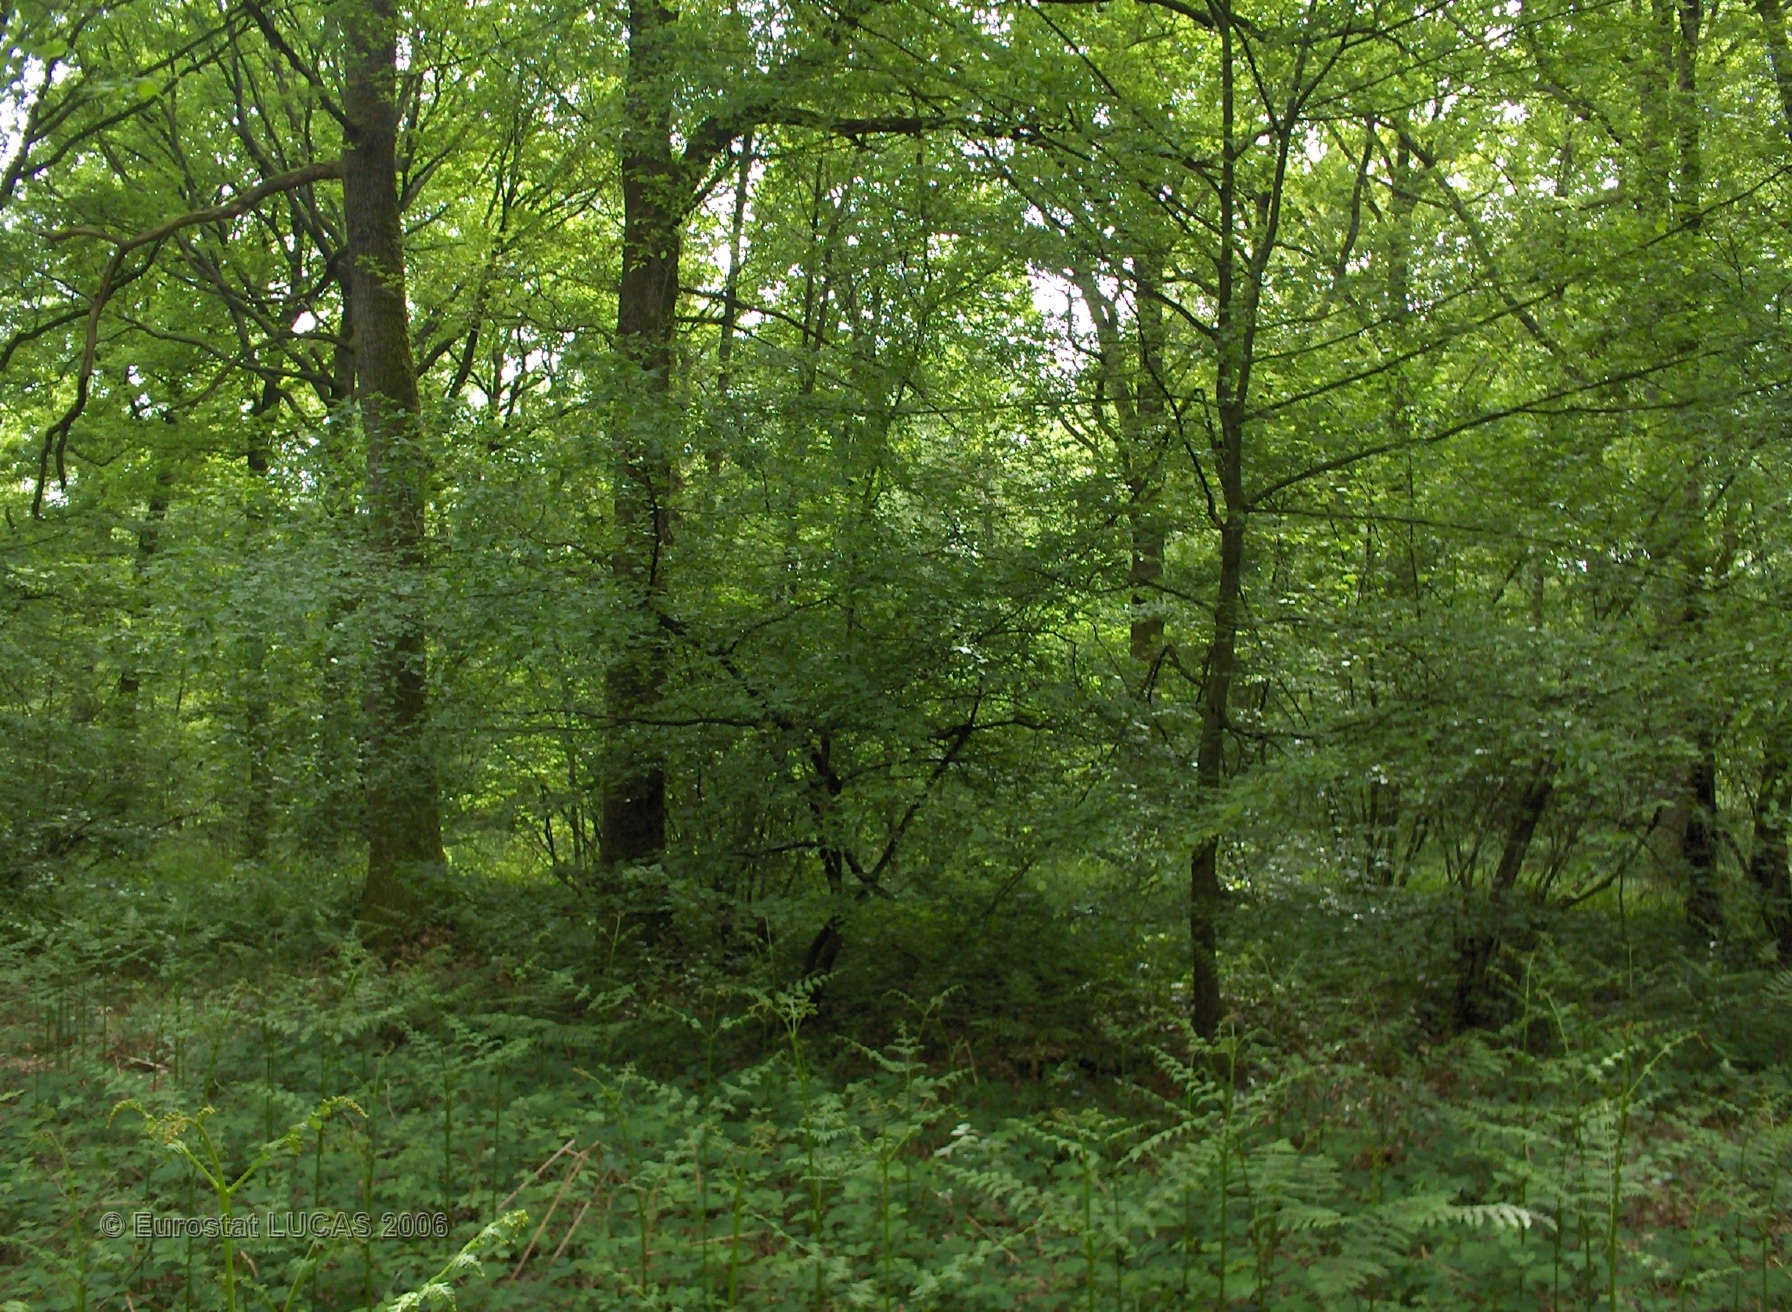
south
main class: Woodland
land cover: Broadleaved forest
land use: Forestry
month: June
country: BE
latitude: 50.2172
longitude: 4.5725
